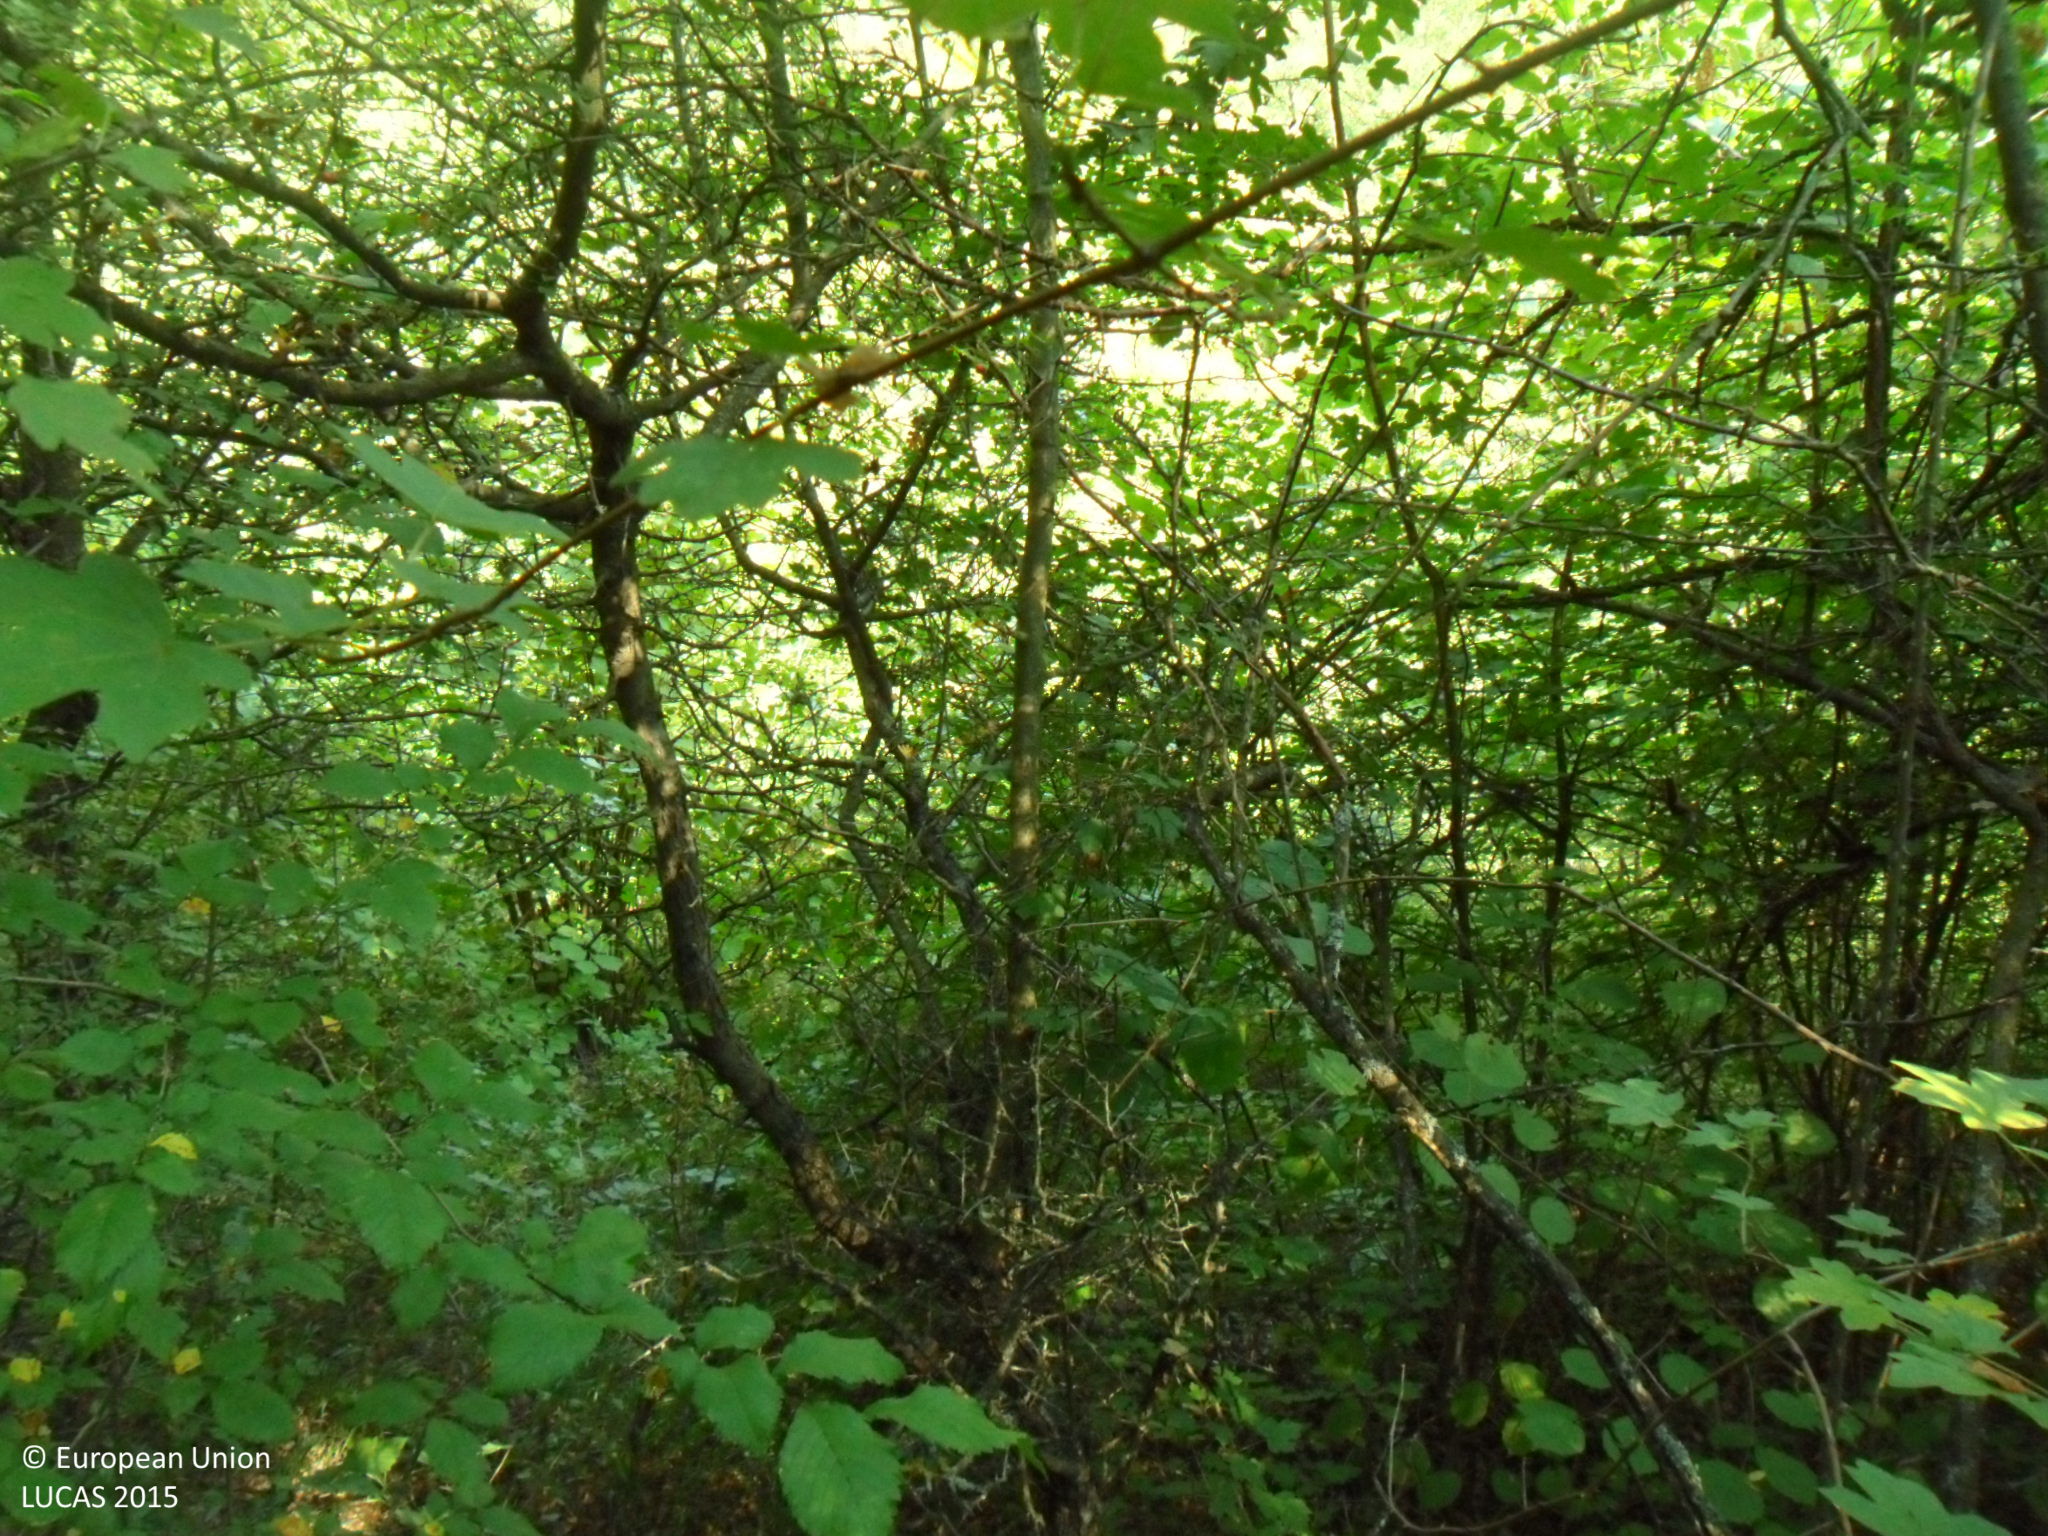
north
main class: Woodland
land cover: Broadleaved woodland
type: mesophytic deciduous forest
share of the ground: 25 - 50 %
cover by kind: shrubs 60 %, broadleaved forest trees 30 %, herbaceous plants 10 %
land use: Forestry
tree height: > 5 m
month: September
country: BG
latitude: 43.4838
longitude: 26.6895
